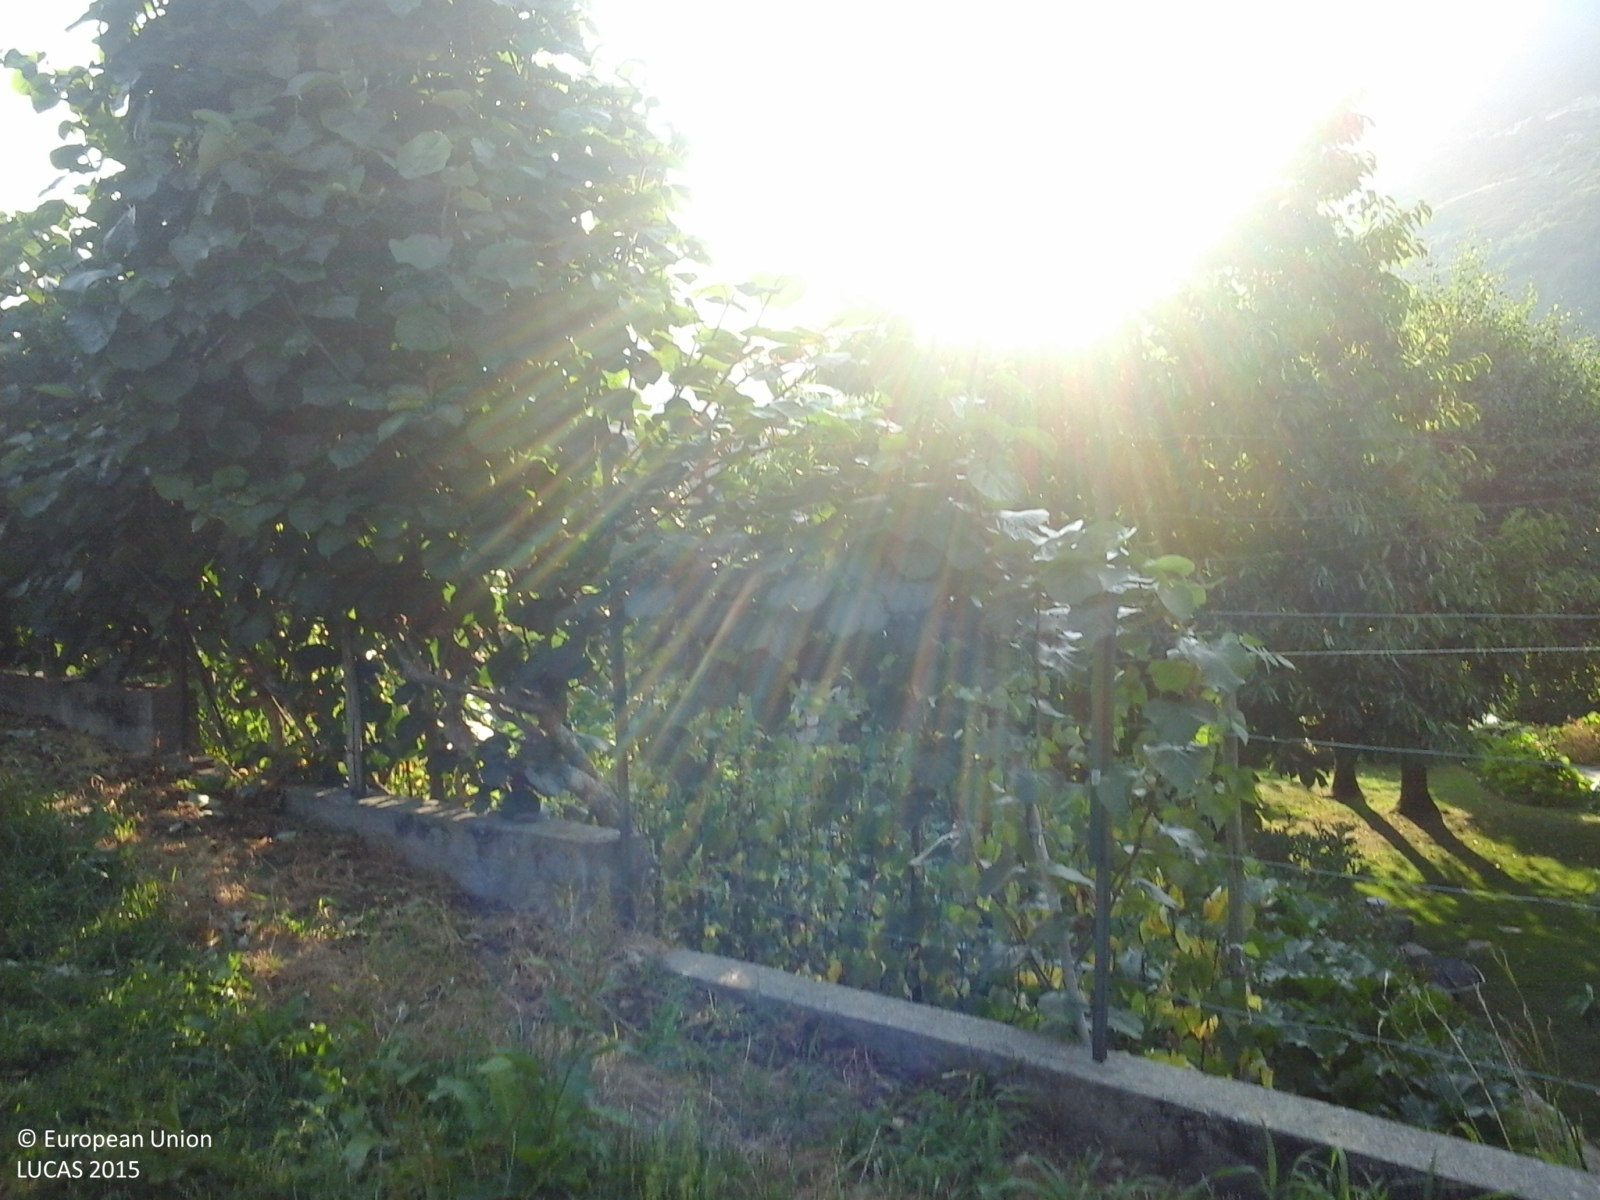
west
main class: Grassland
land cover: Grassland with sparse tree/shrub cover
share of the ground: > 75 %
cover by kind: herbaceous plants 85 %, shrubs 10 %, broadleaved forest trees 5 %
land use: Residential
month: July
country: IT
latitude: 46.2249
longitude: 10.1942
